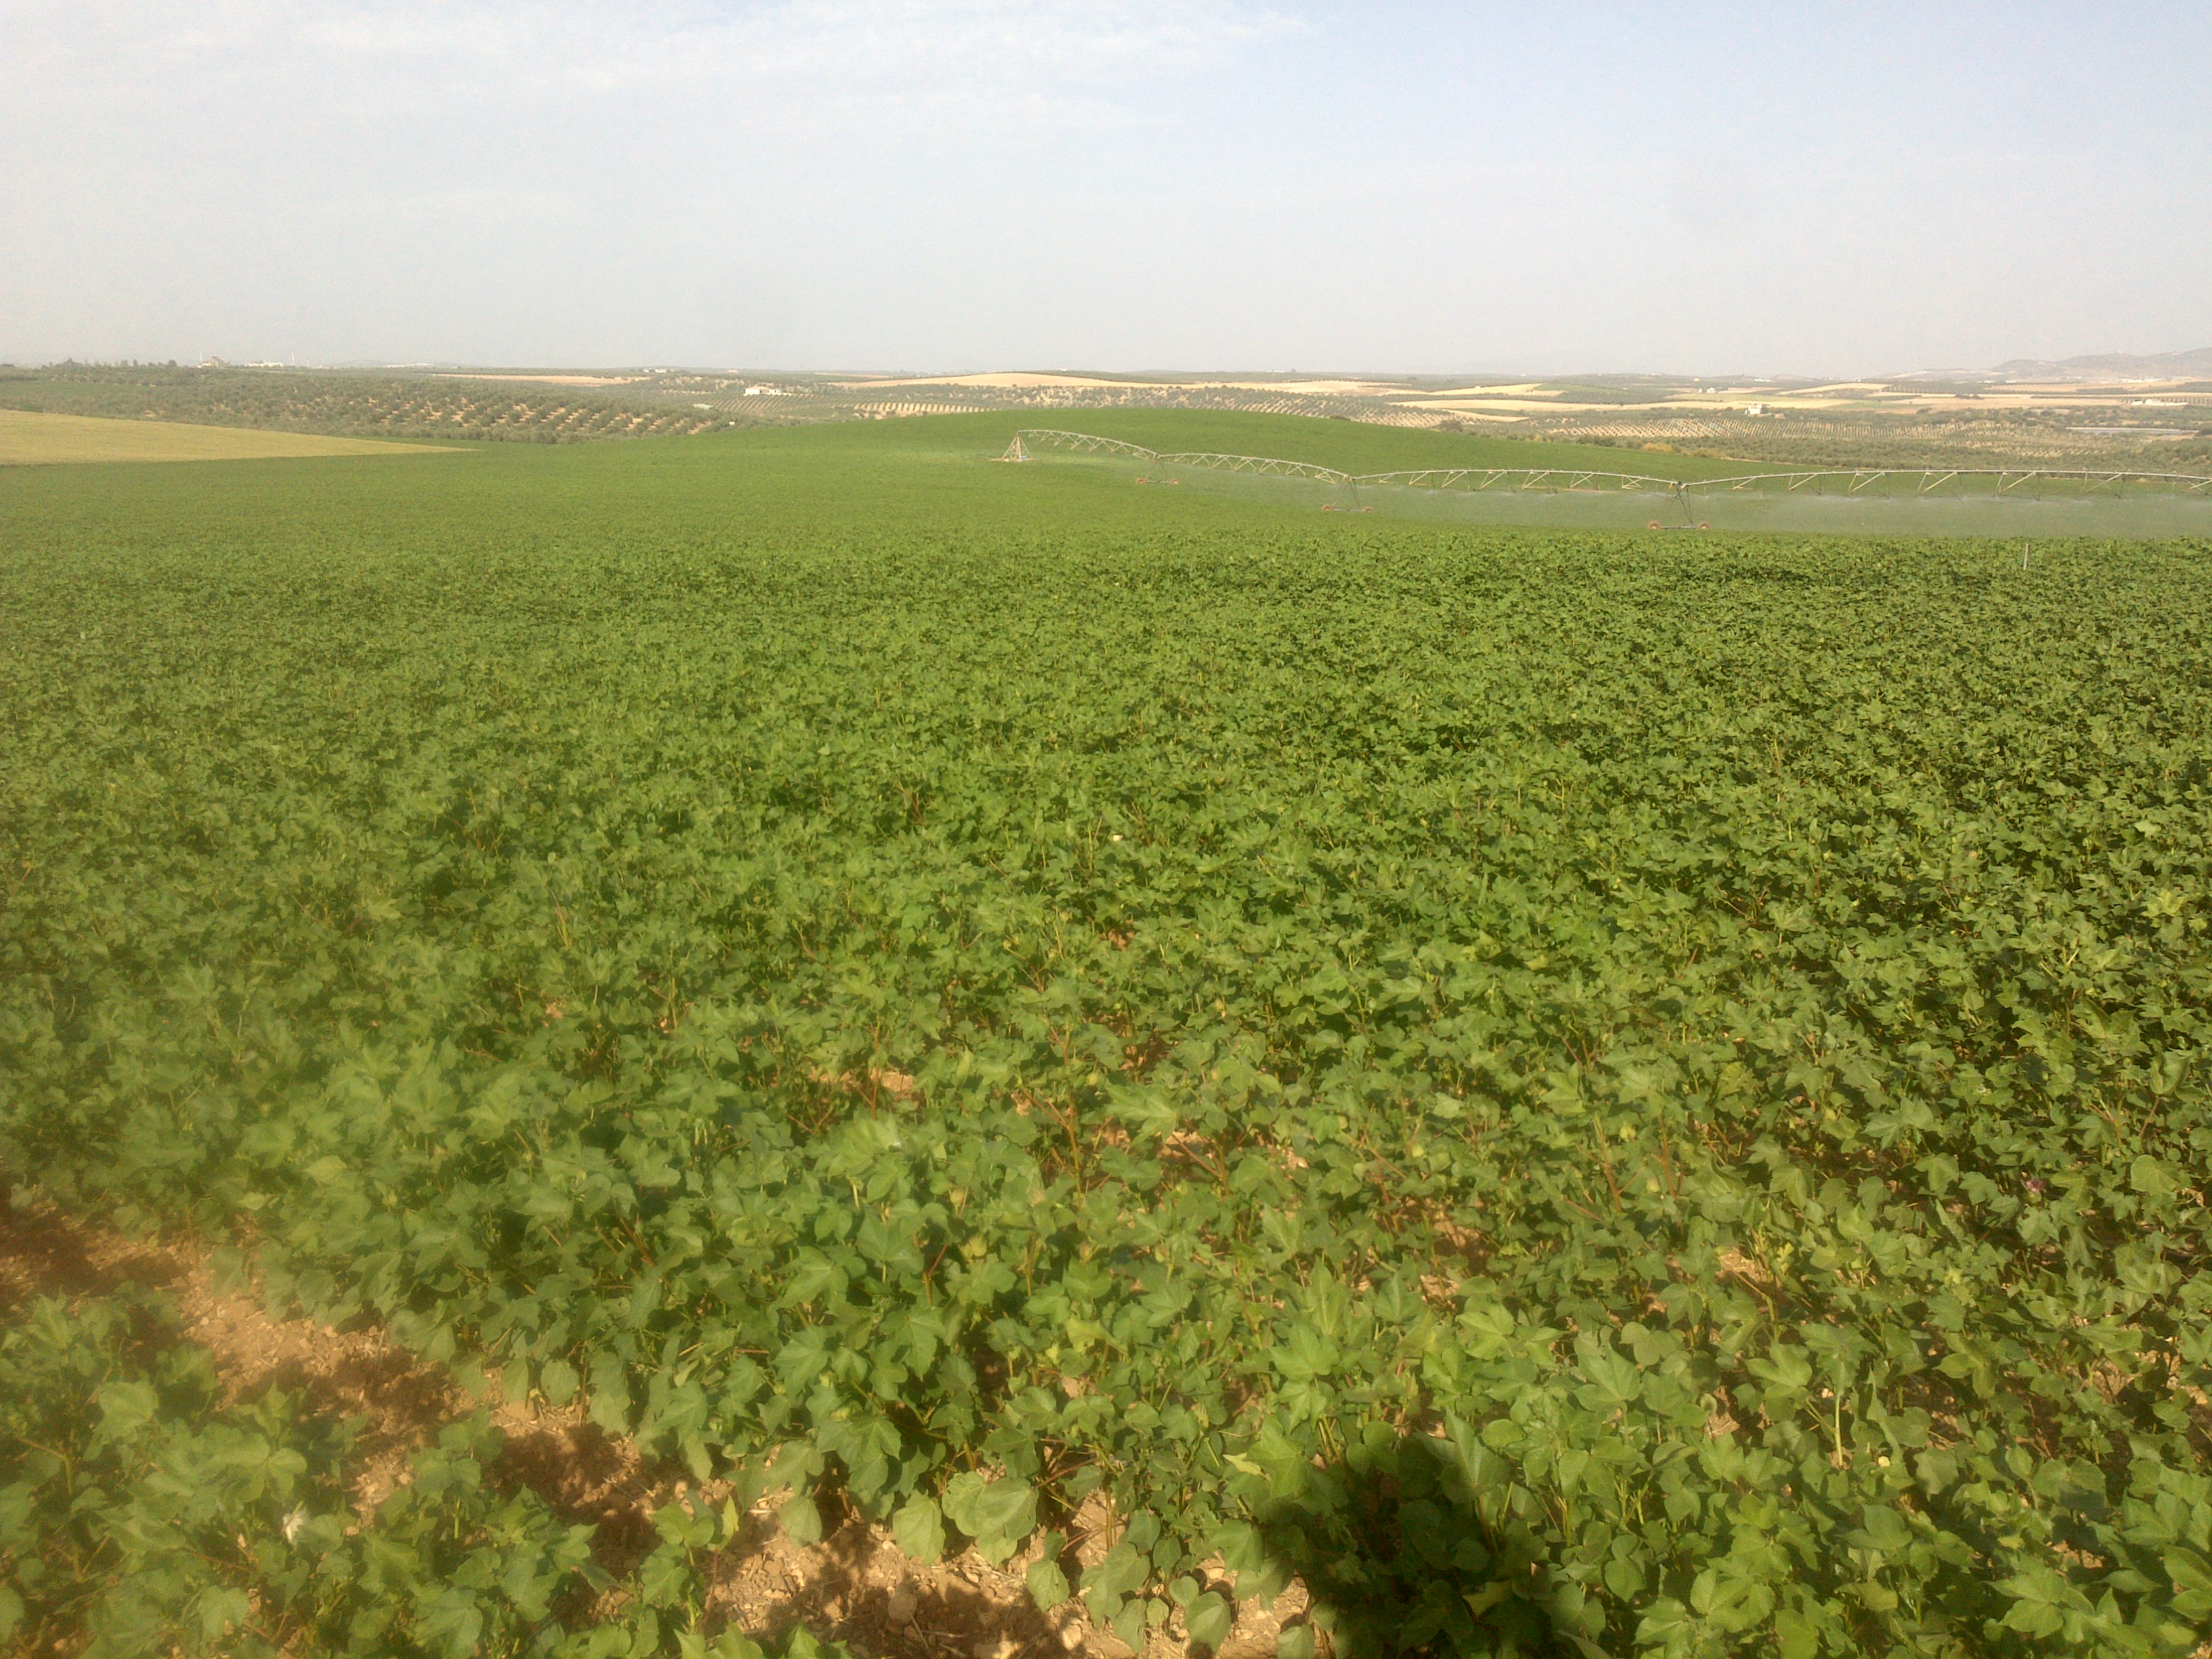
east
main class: Cropland
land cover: Cotton
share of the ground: 50 - 75 %
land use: Agriculture (excluding fallow land and kitchen gardens)
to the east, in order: Cotton
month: July
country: ES
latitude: 37.4397
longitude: -4.8478
